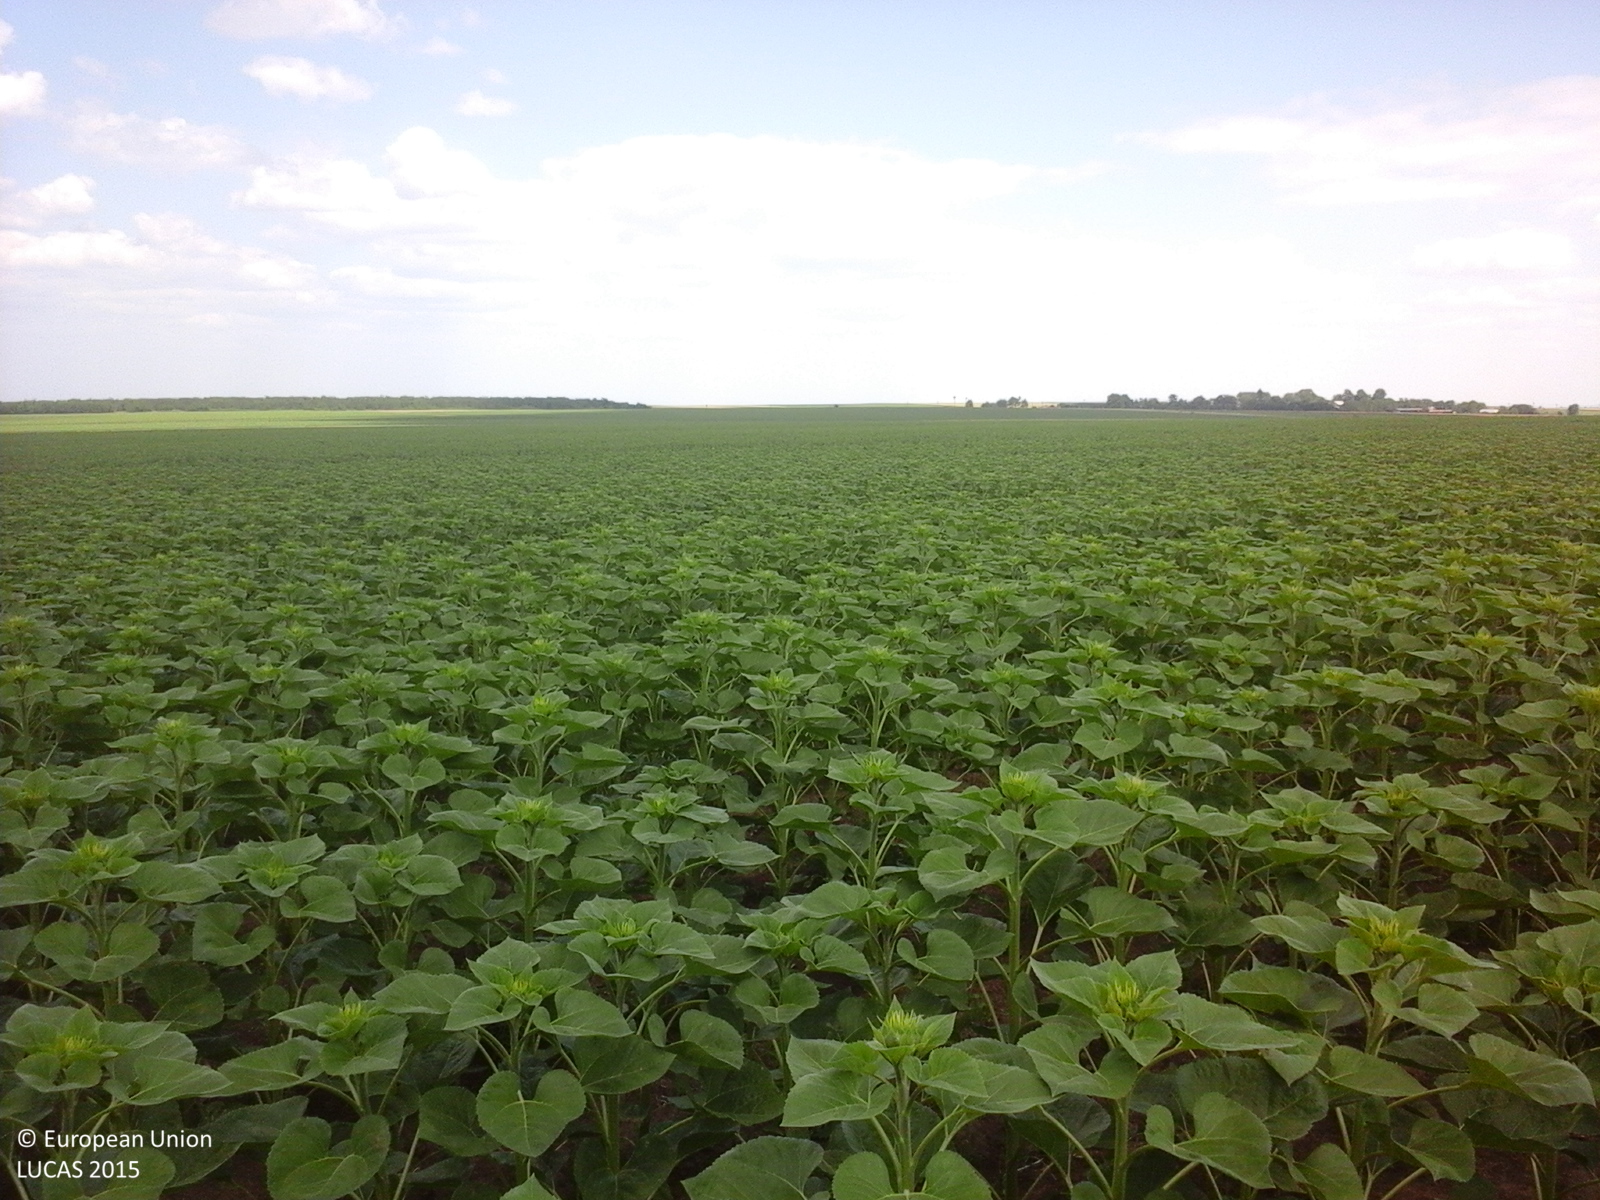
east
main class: Cropland
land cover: Sunflower
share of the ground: > 75 %
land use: Agriculture (excluding fallow land and kitchen gardens)
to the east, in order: Sunflower; Maize; Sunflower
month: June
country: RO
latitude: 47.8988
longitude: 26.4220
